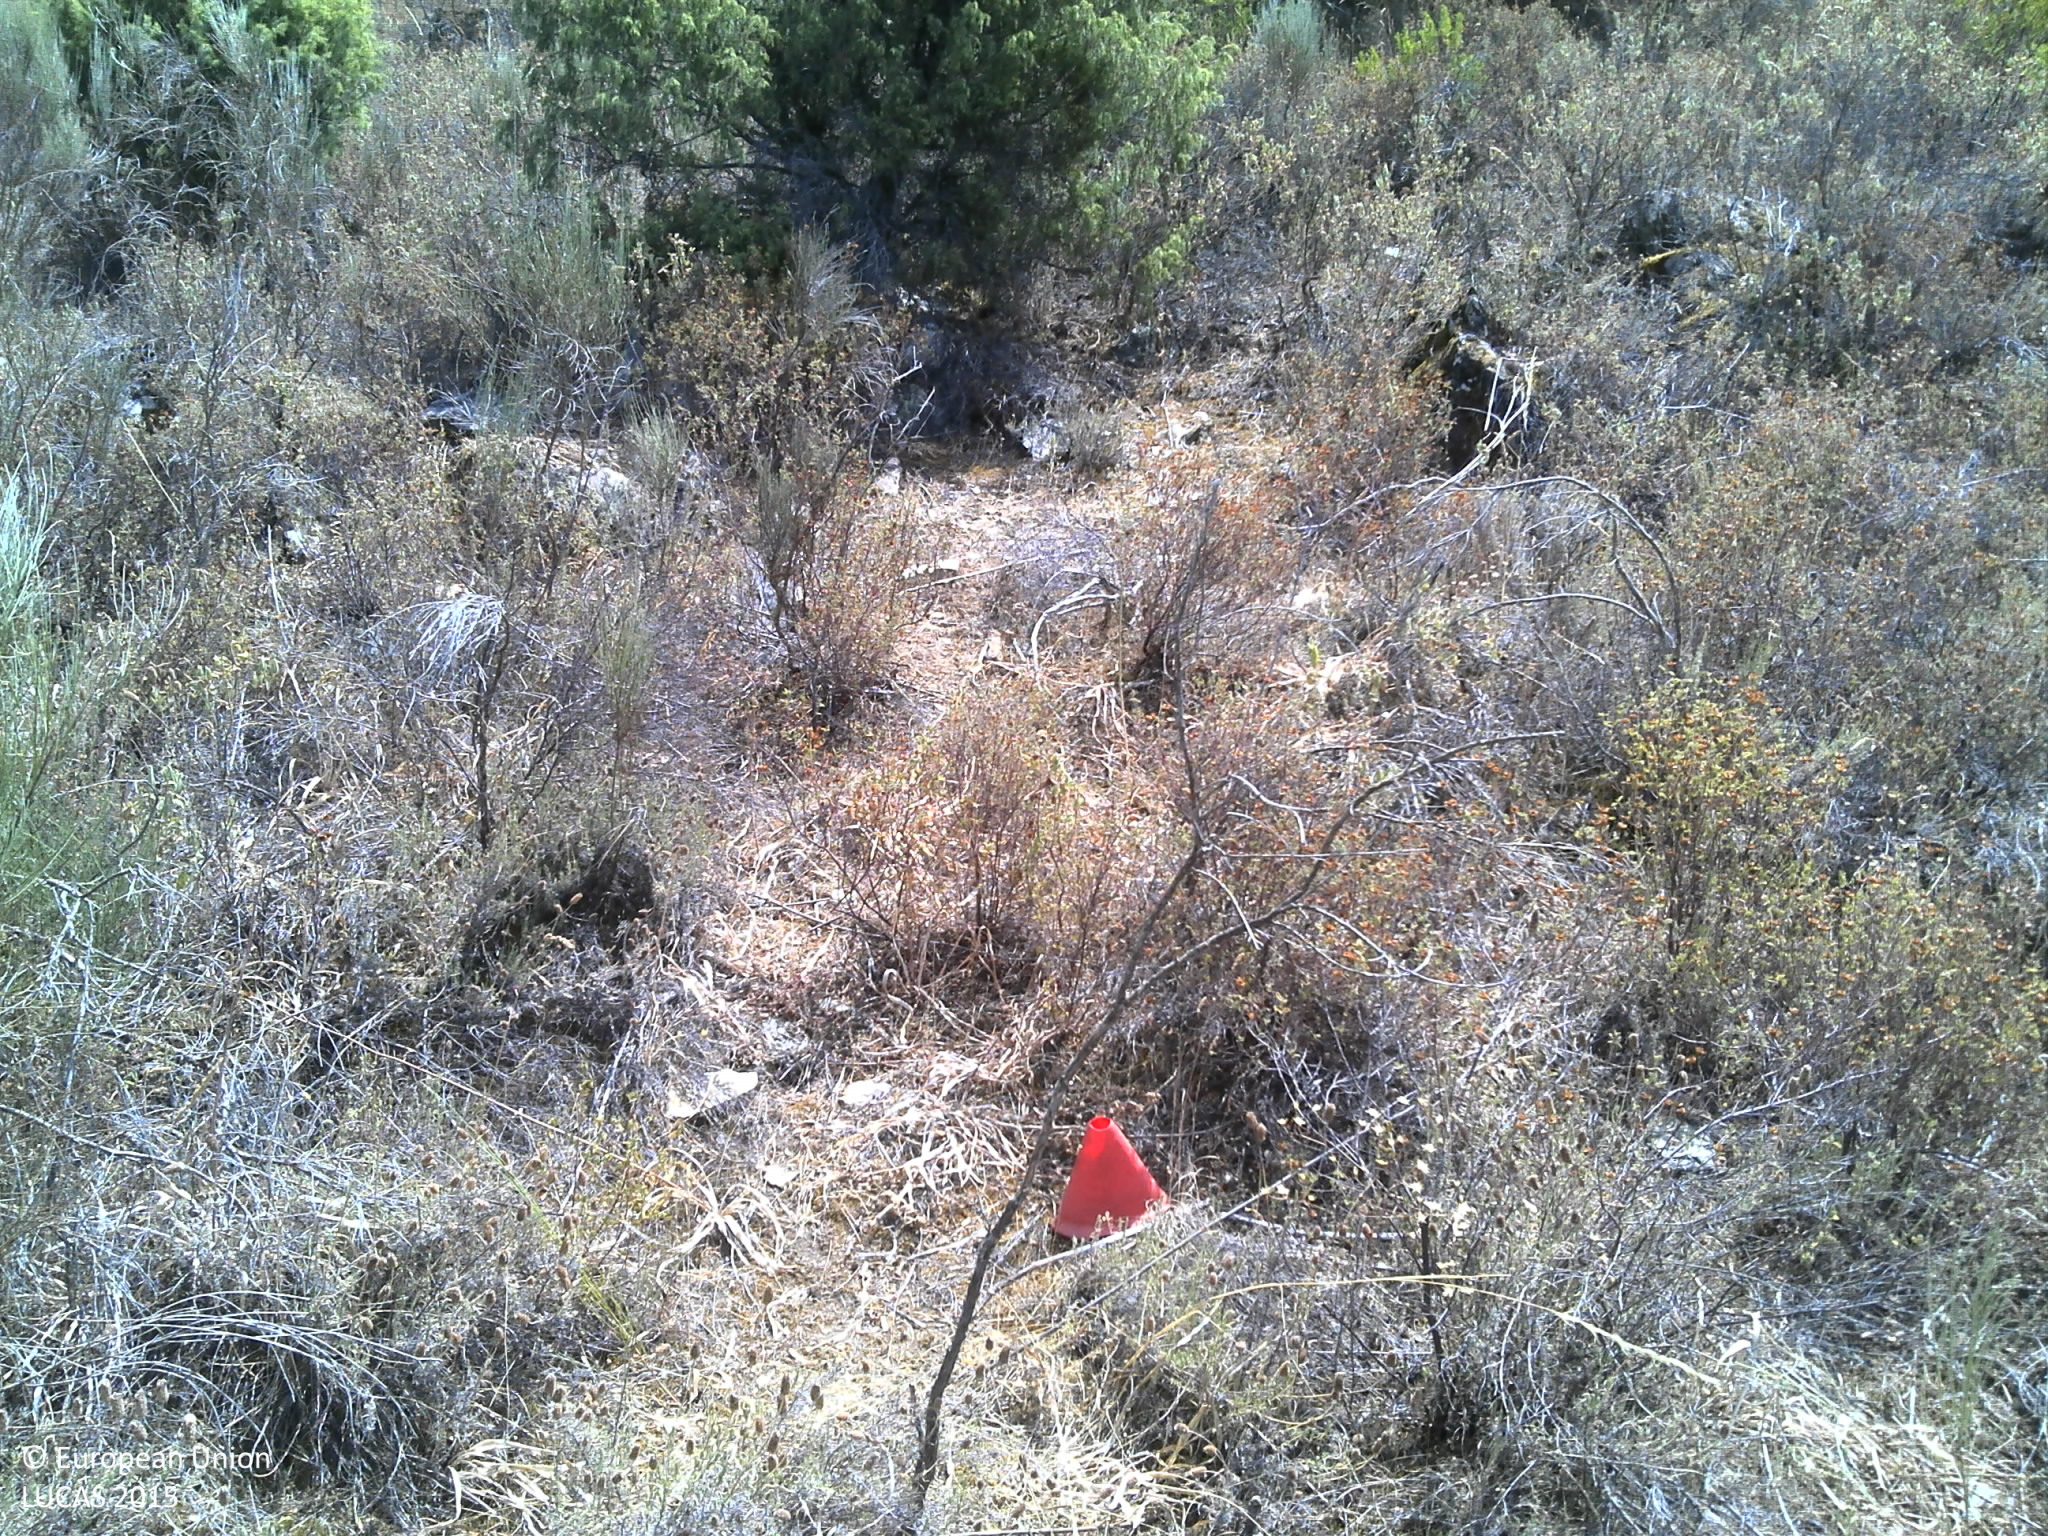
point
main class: Woodland
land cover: Broadleaved woodland
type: broadleaved evergreen forest
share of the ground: 10 - 25 %
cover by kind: shrubs 70 %, broadleaved forest trees 20 %, coniferous forest trees 5 %, unconsolidated bare surface 5 %
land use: Semi-natural and natural areas not in use
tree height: < 5 m
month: July
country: PT
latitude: 41.1284
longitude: -7.3293
